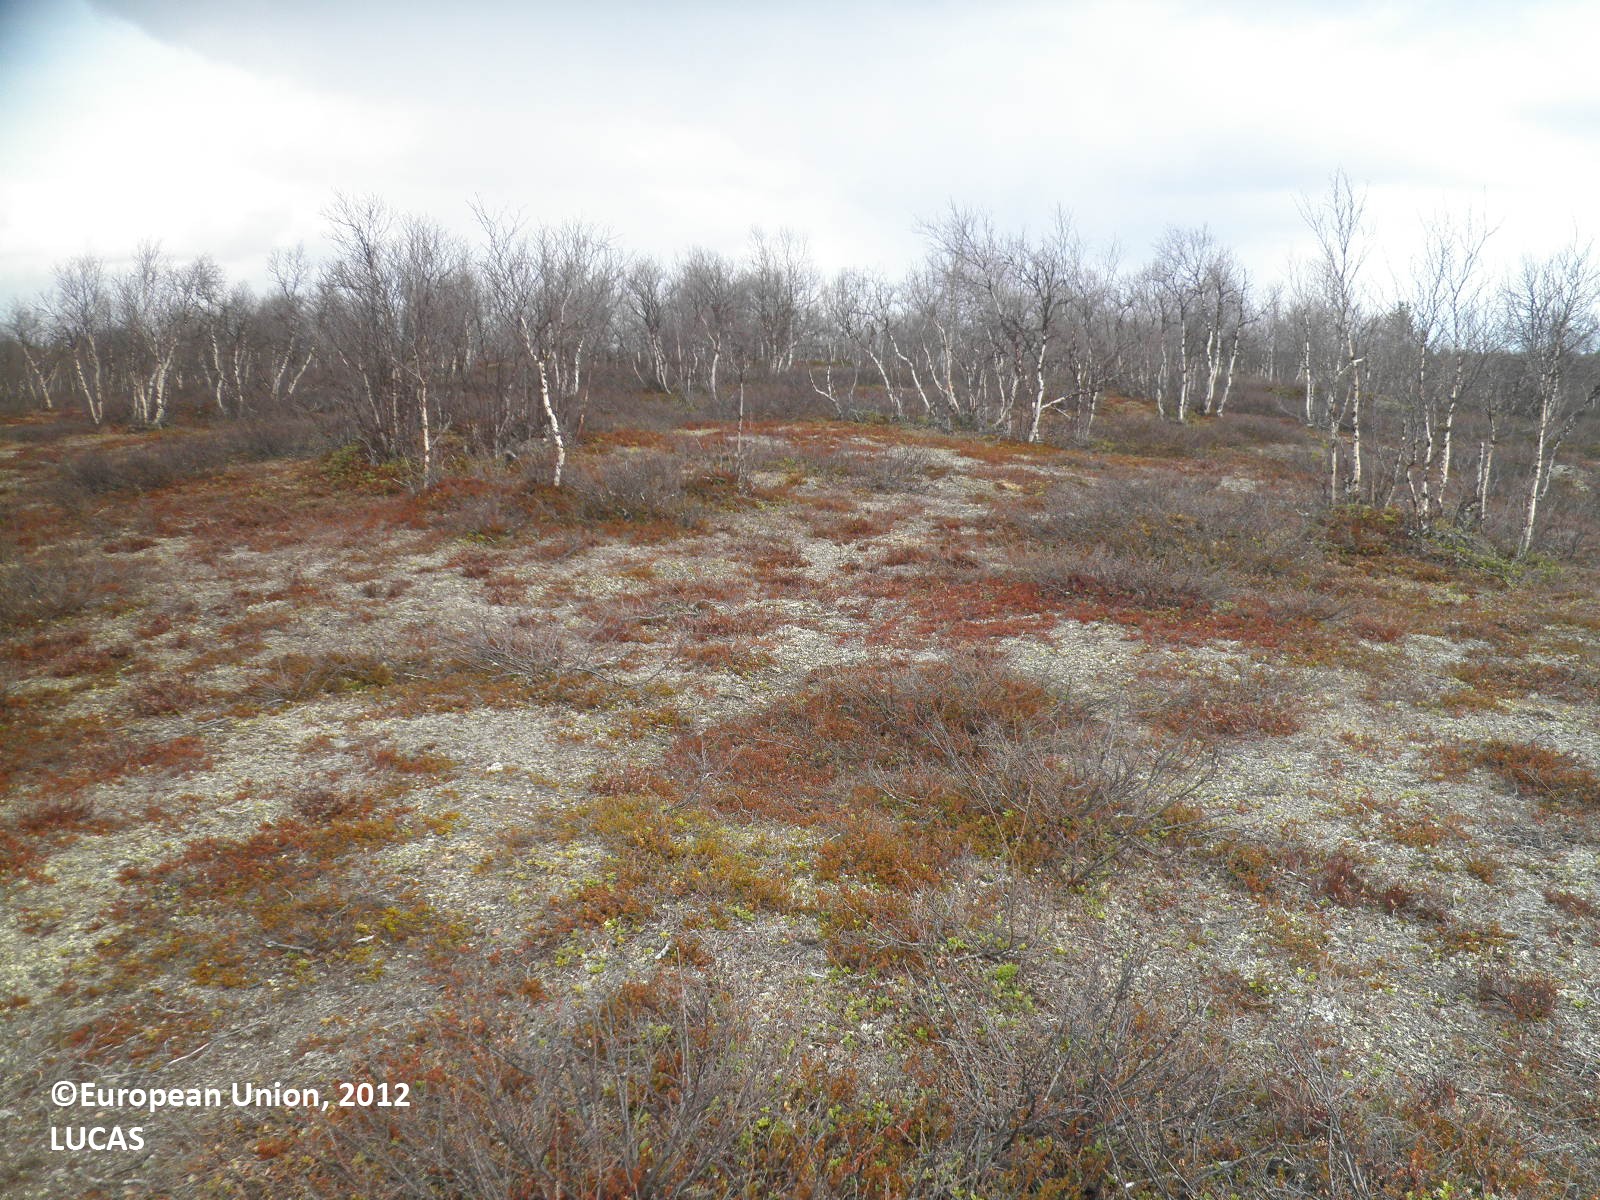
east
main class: Shrubland
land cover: Shrubland with sparse tree cover
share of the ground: 25 - 50 %
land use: Forestry
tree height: < 5 m
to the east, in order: Shrubland with sparse tree cover; Broadleaved woodland; Shrubland with sparse tree cover; Inland water bodies
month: May
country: FI
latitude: 69.3220
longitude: 26.6124
